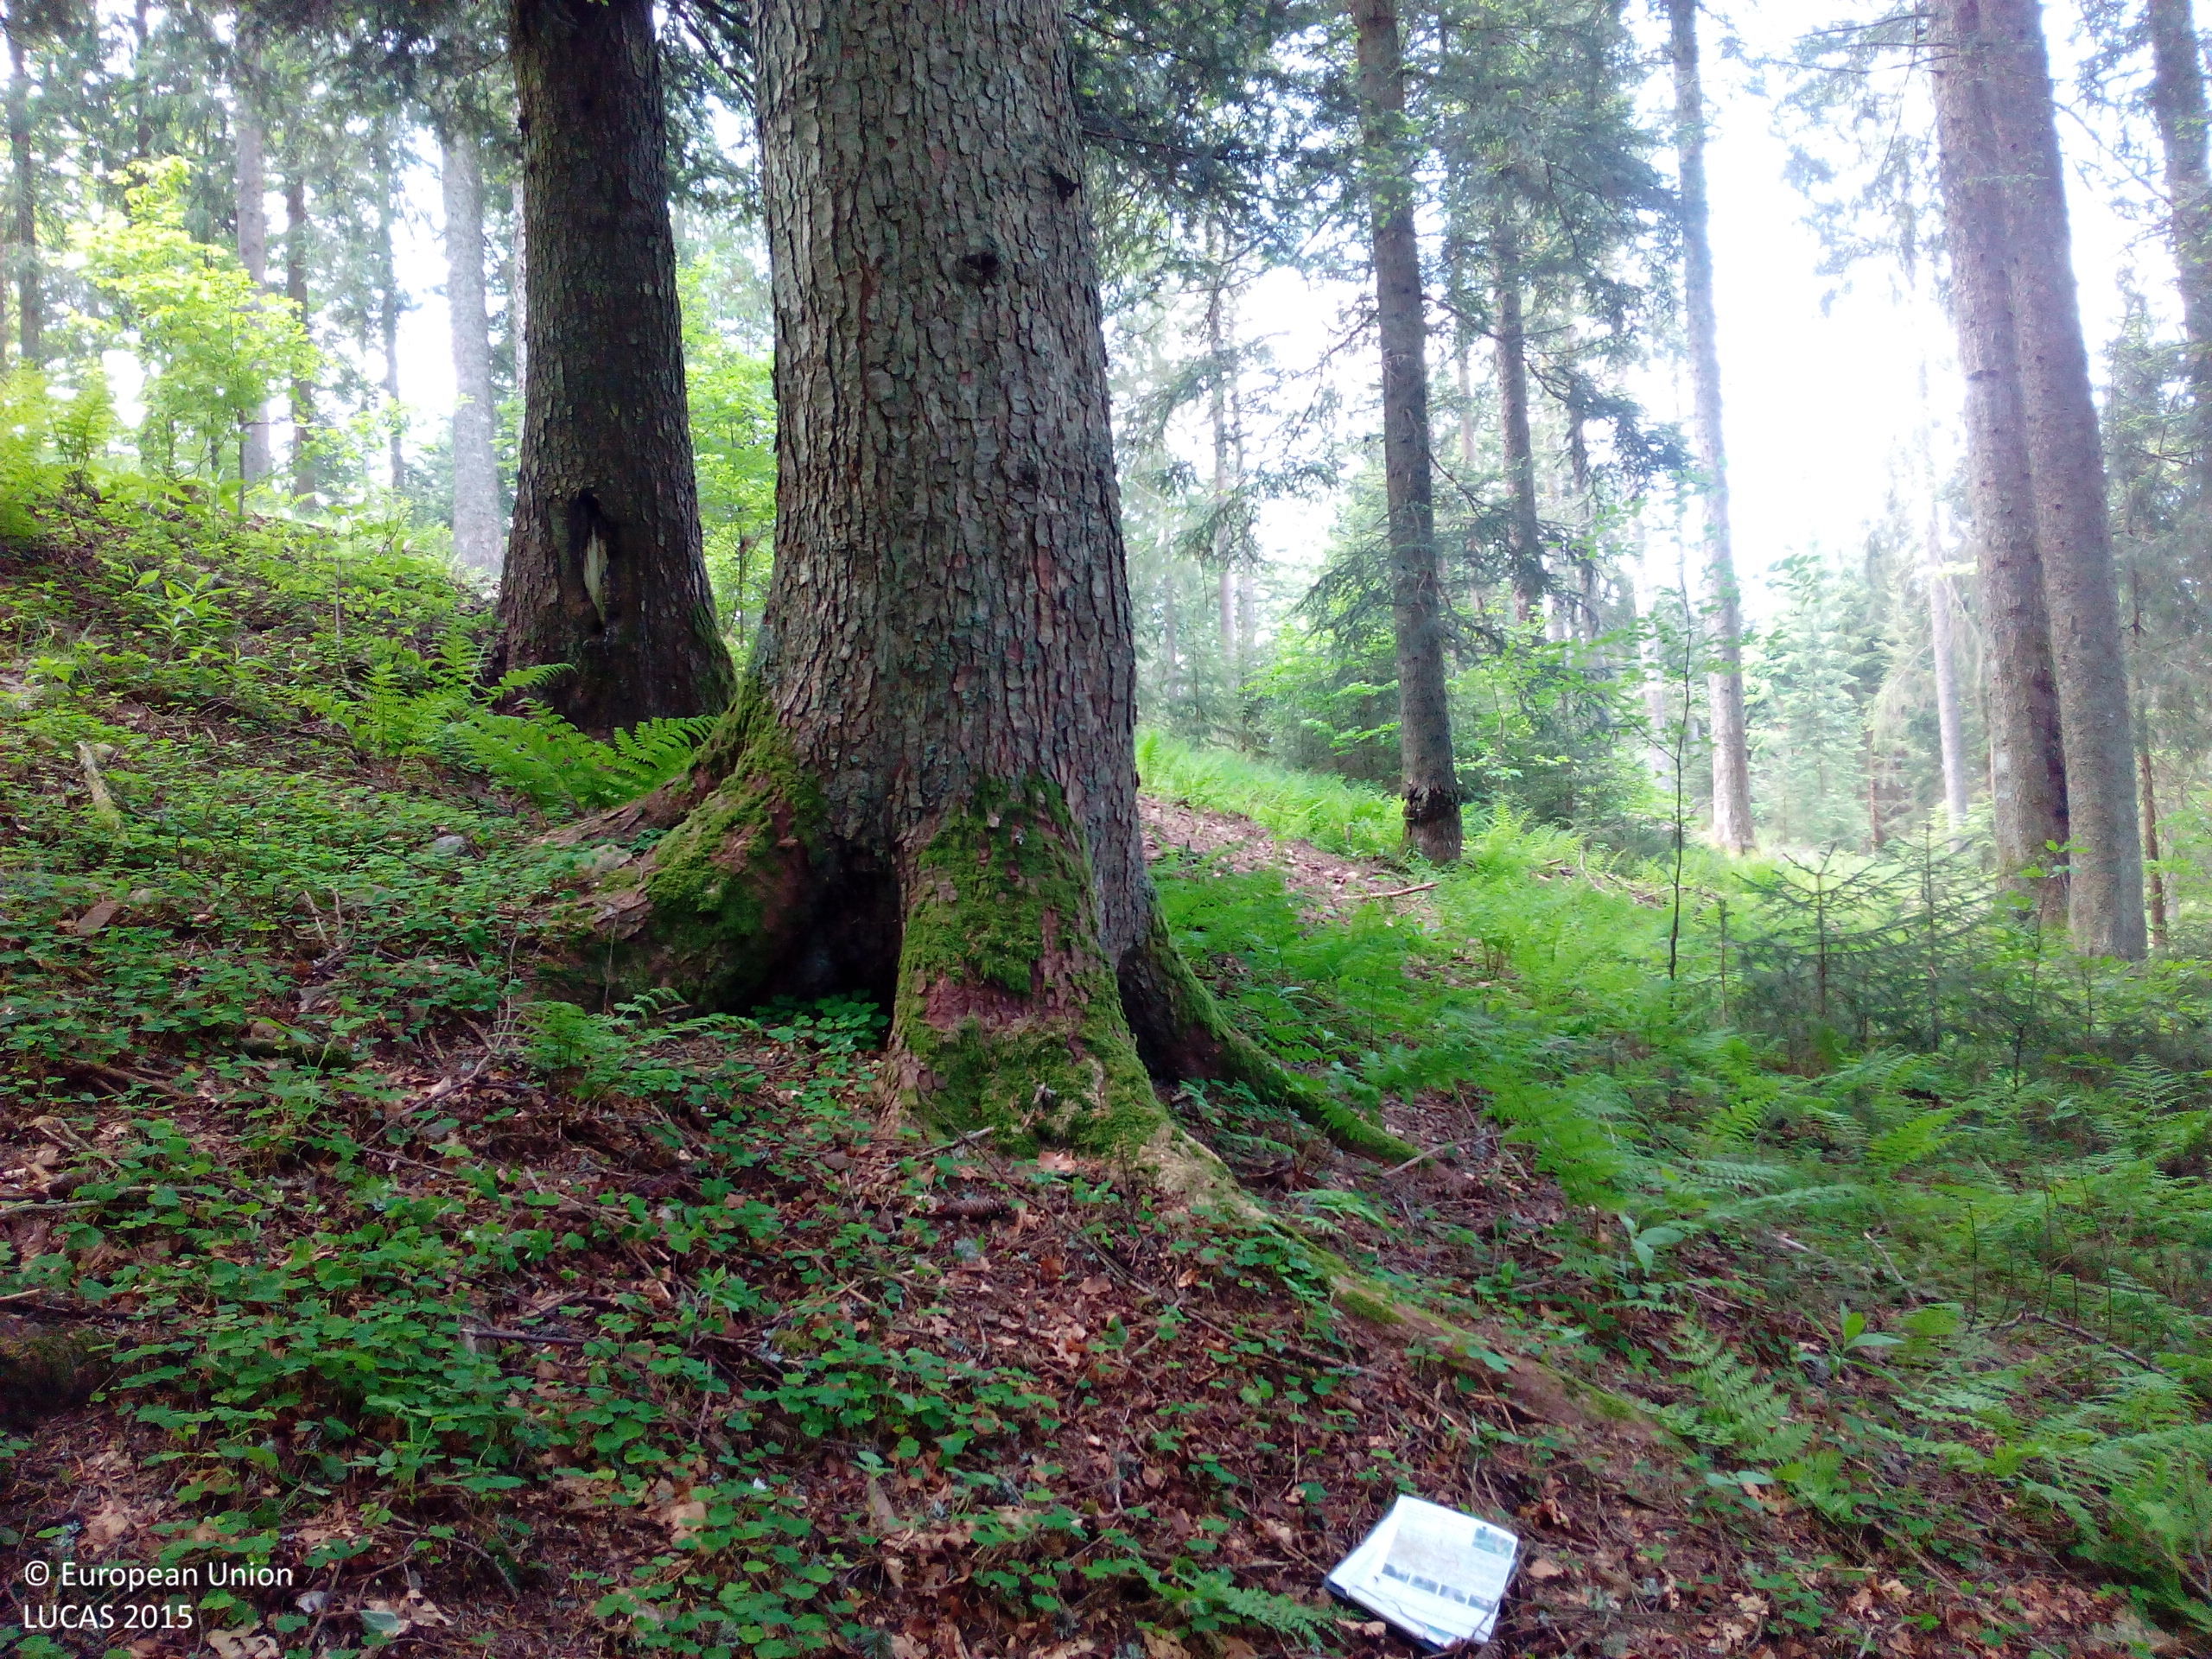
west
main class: Woodland
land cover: Other mixed woodland
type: hemiboreal forest and nemoral coniferous forest and mixed broadleaved-coniferous forest
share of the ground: > 75 %
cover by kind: coniferous forest trees 75 %, broadleaved forest trees 25 %
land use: Forestry
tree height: > 5 m
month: May
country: DE
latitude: 48.0107
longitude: 8.1913
